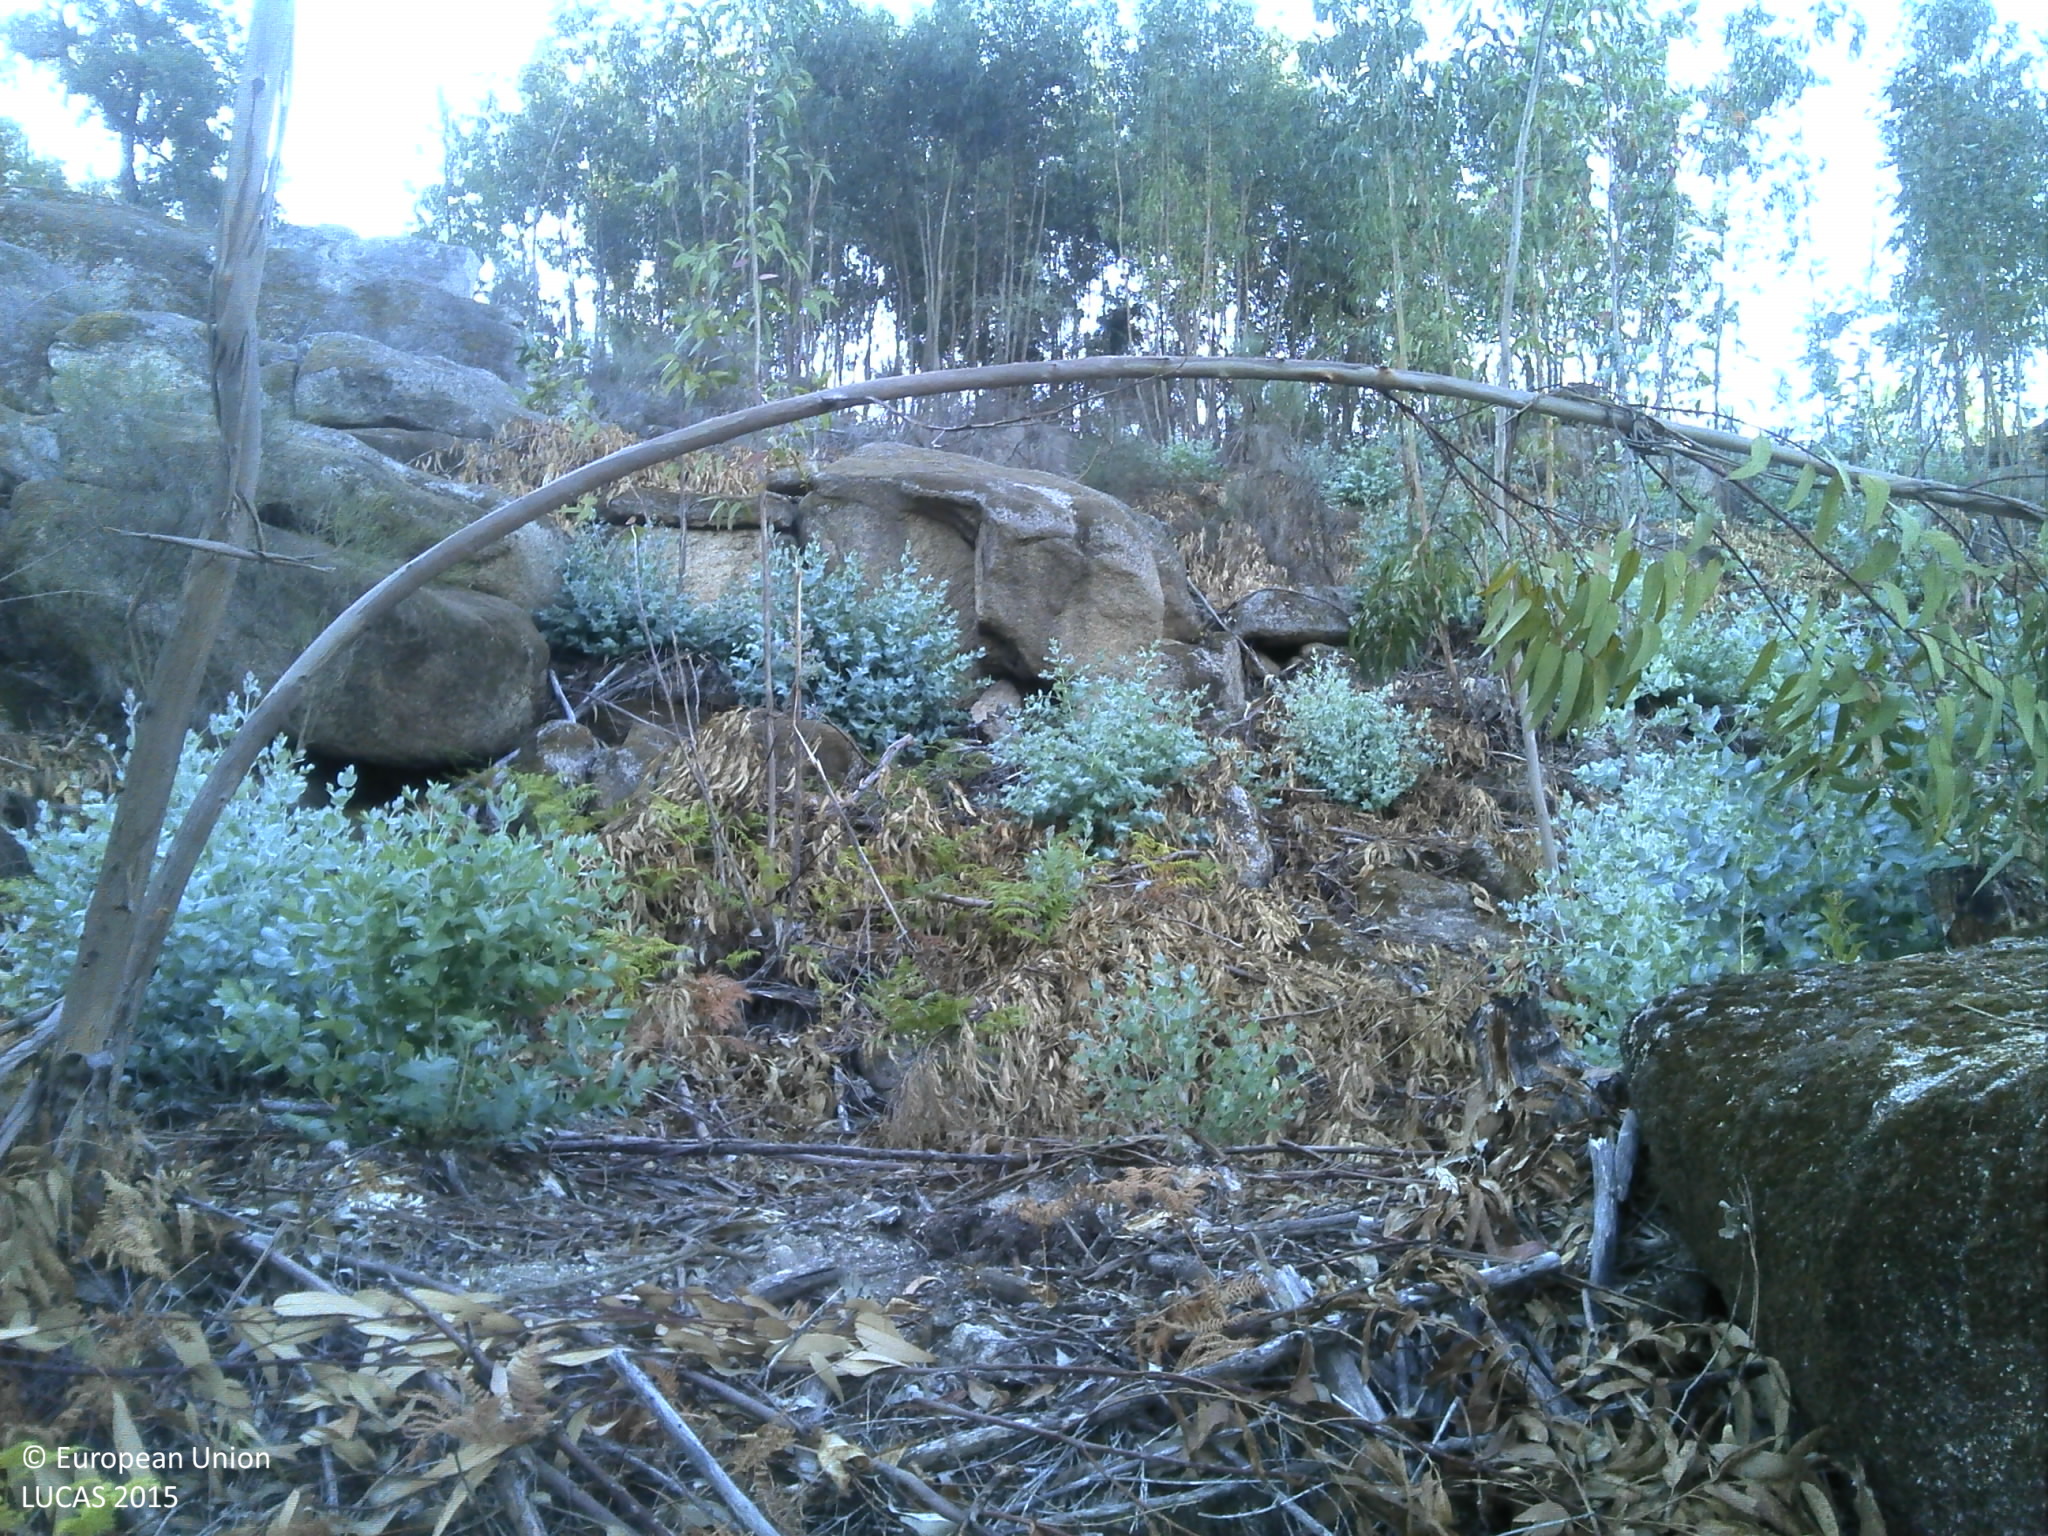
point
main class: Woodland
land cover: Broadleaved woodland
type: acidophilous oak and oak-birch forest
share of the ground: 25 - 50 %
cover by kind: broadleaved forest trees 45 %, consolidated bare surface 30 %, shrubs 15 %, unconsolidated bare surface 5 %
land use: Forestry
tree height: > 5 m
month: June
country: PT
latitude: 40.1025
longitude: -7.1884
